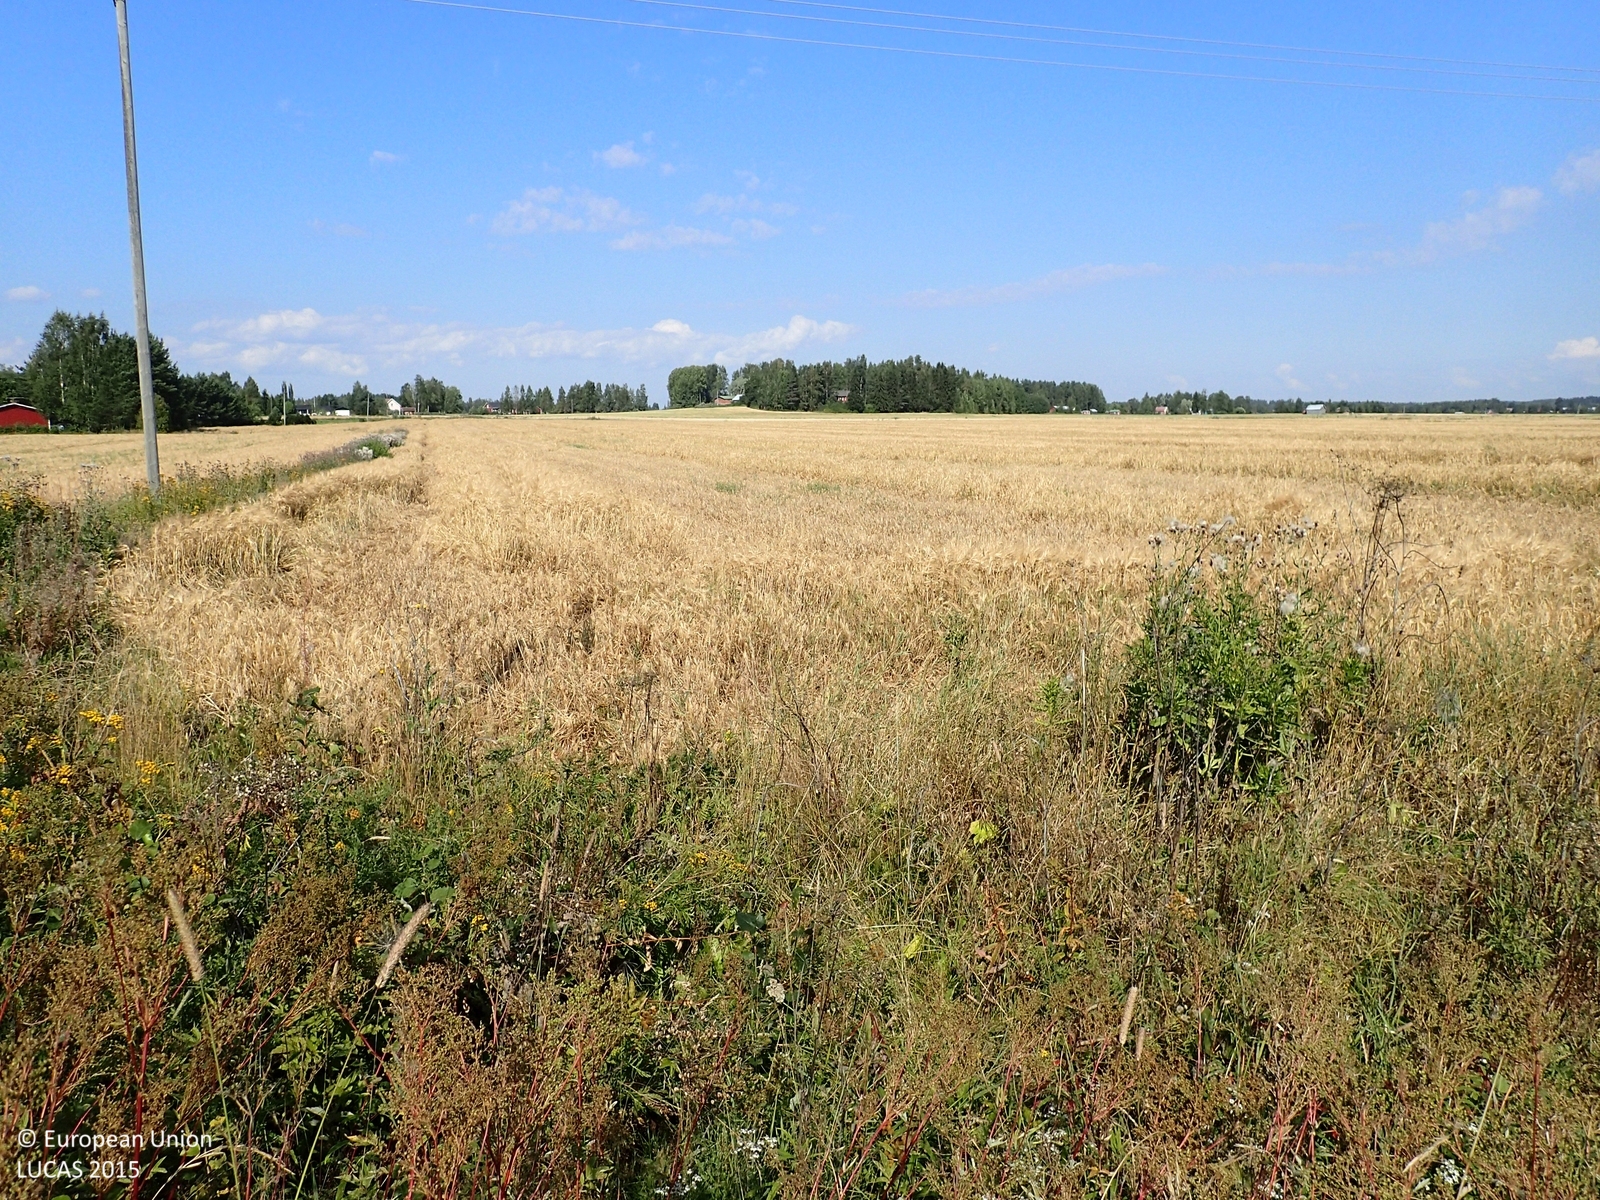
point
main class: Cropland
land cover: Barley
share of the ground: > 75 %
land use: Agriculture (excluding fallow land and kitchen gardens)
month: August
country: FI
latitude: 62.6961
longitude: 22.4621
